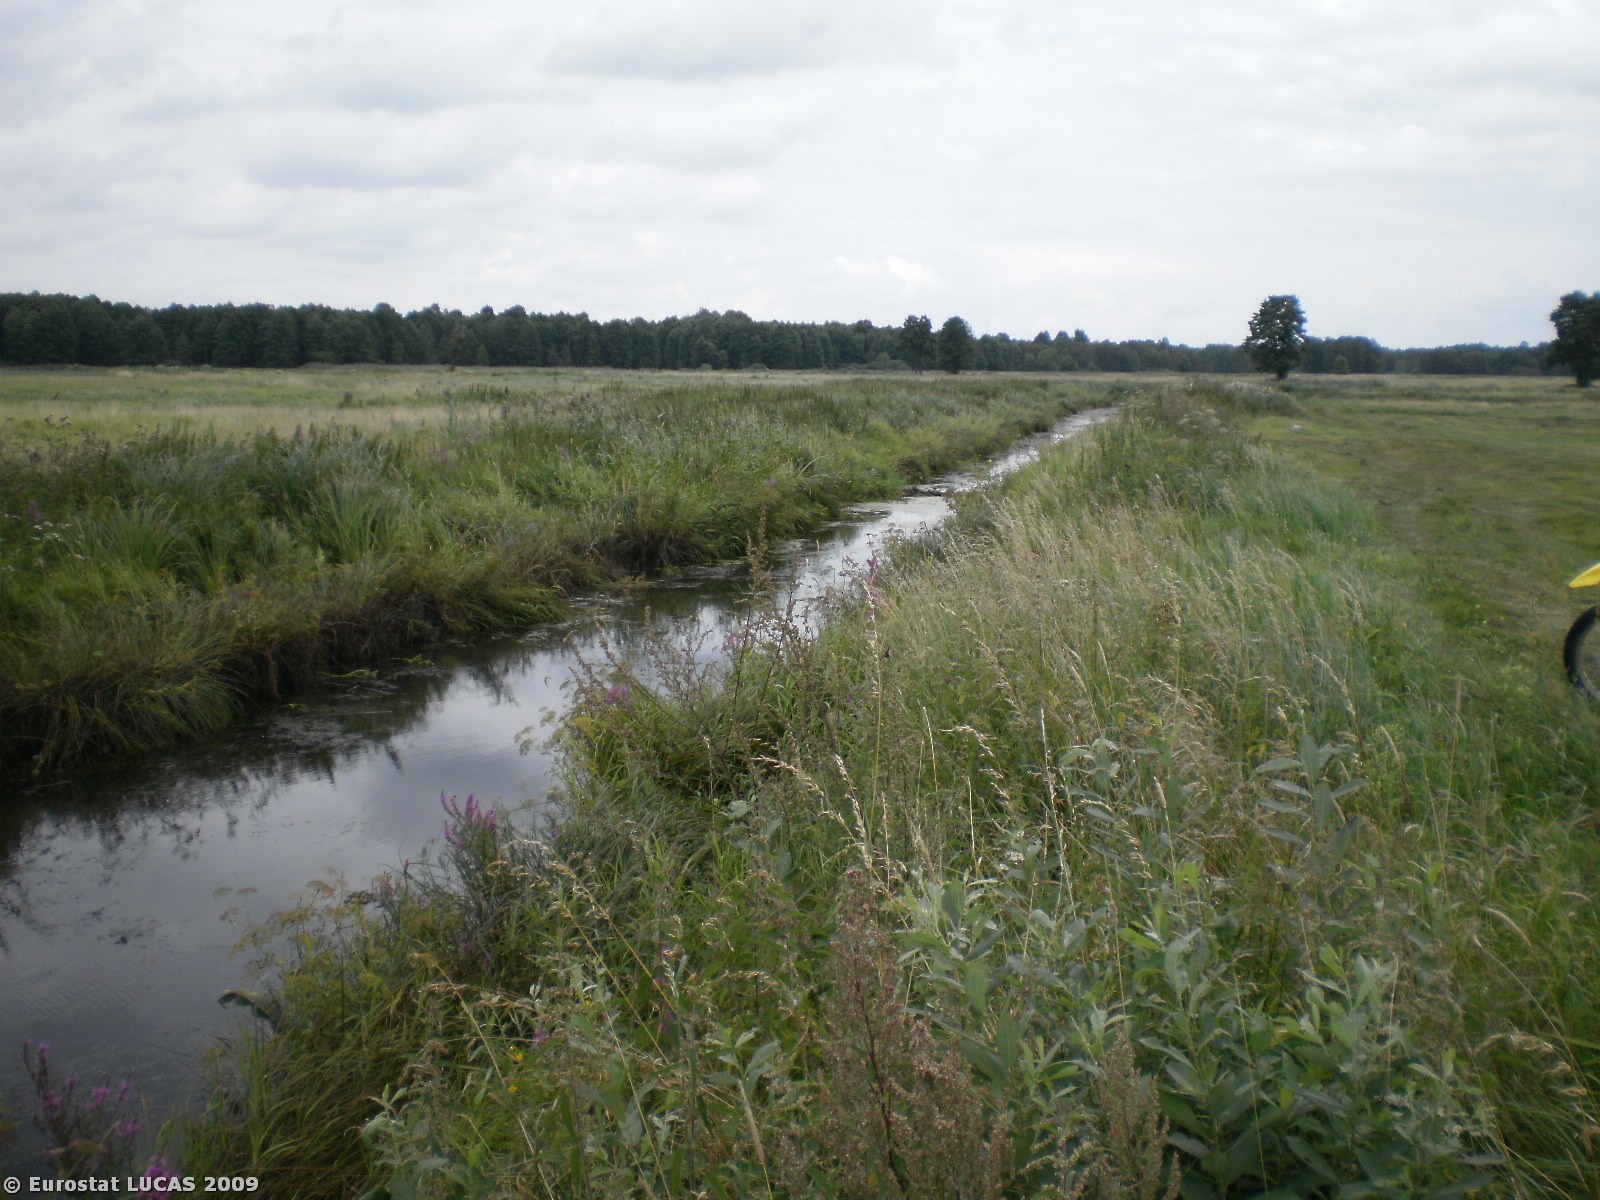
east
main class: Grassland
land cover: Grassland without tree/shrub cover
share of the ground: > 75 %
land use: Nature reserves
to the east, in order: Grassland without tree/shrub cover; Inland running water
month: August
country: PL
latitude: 53.2372
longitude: 21.2694
